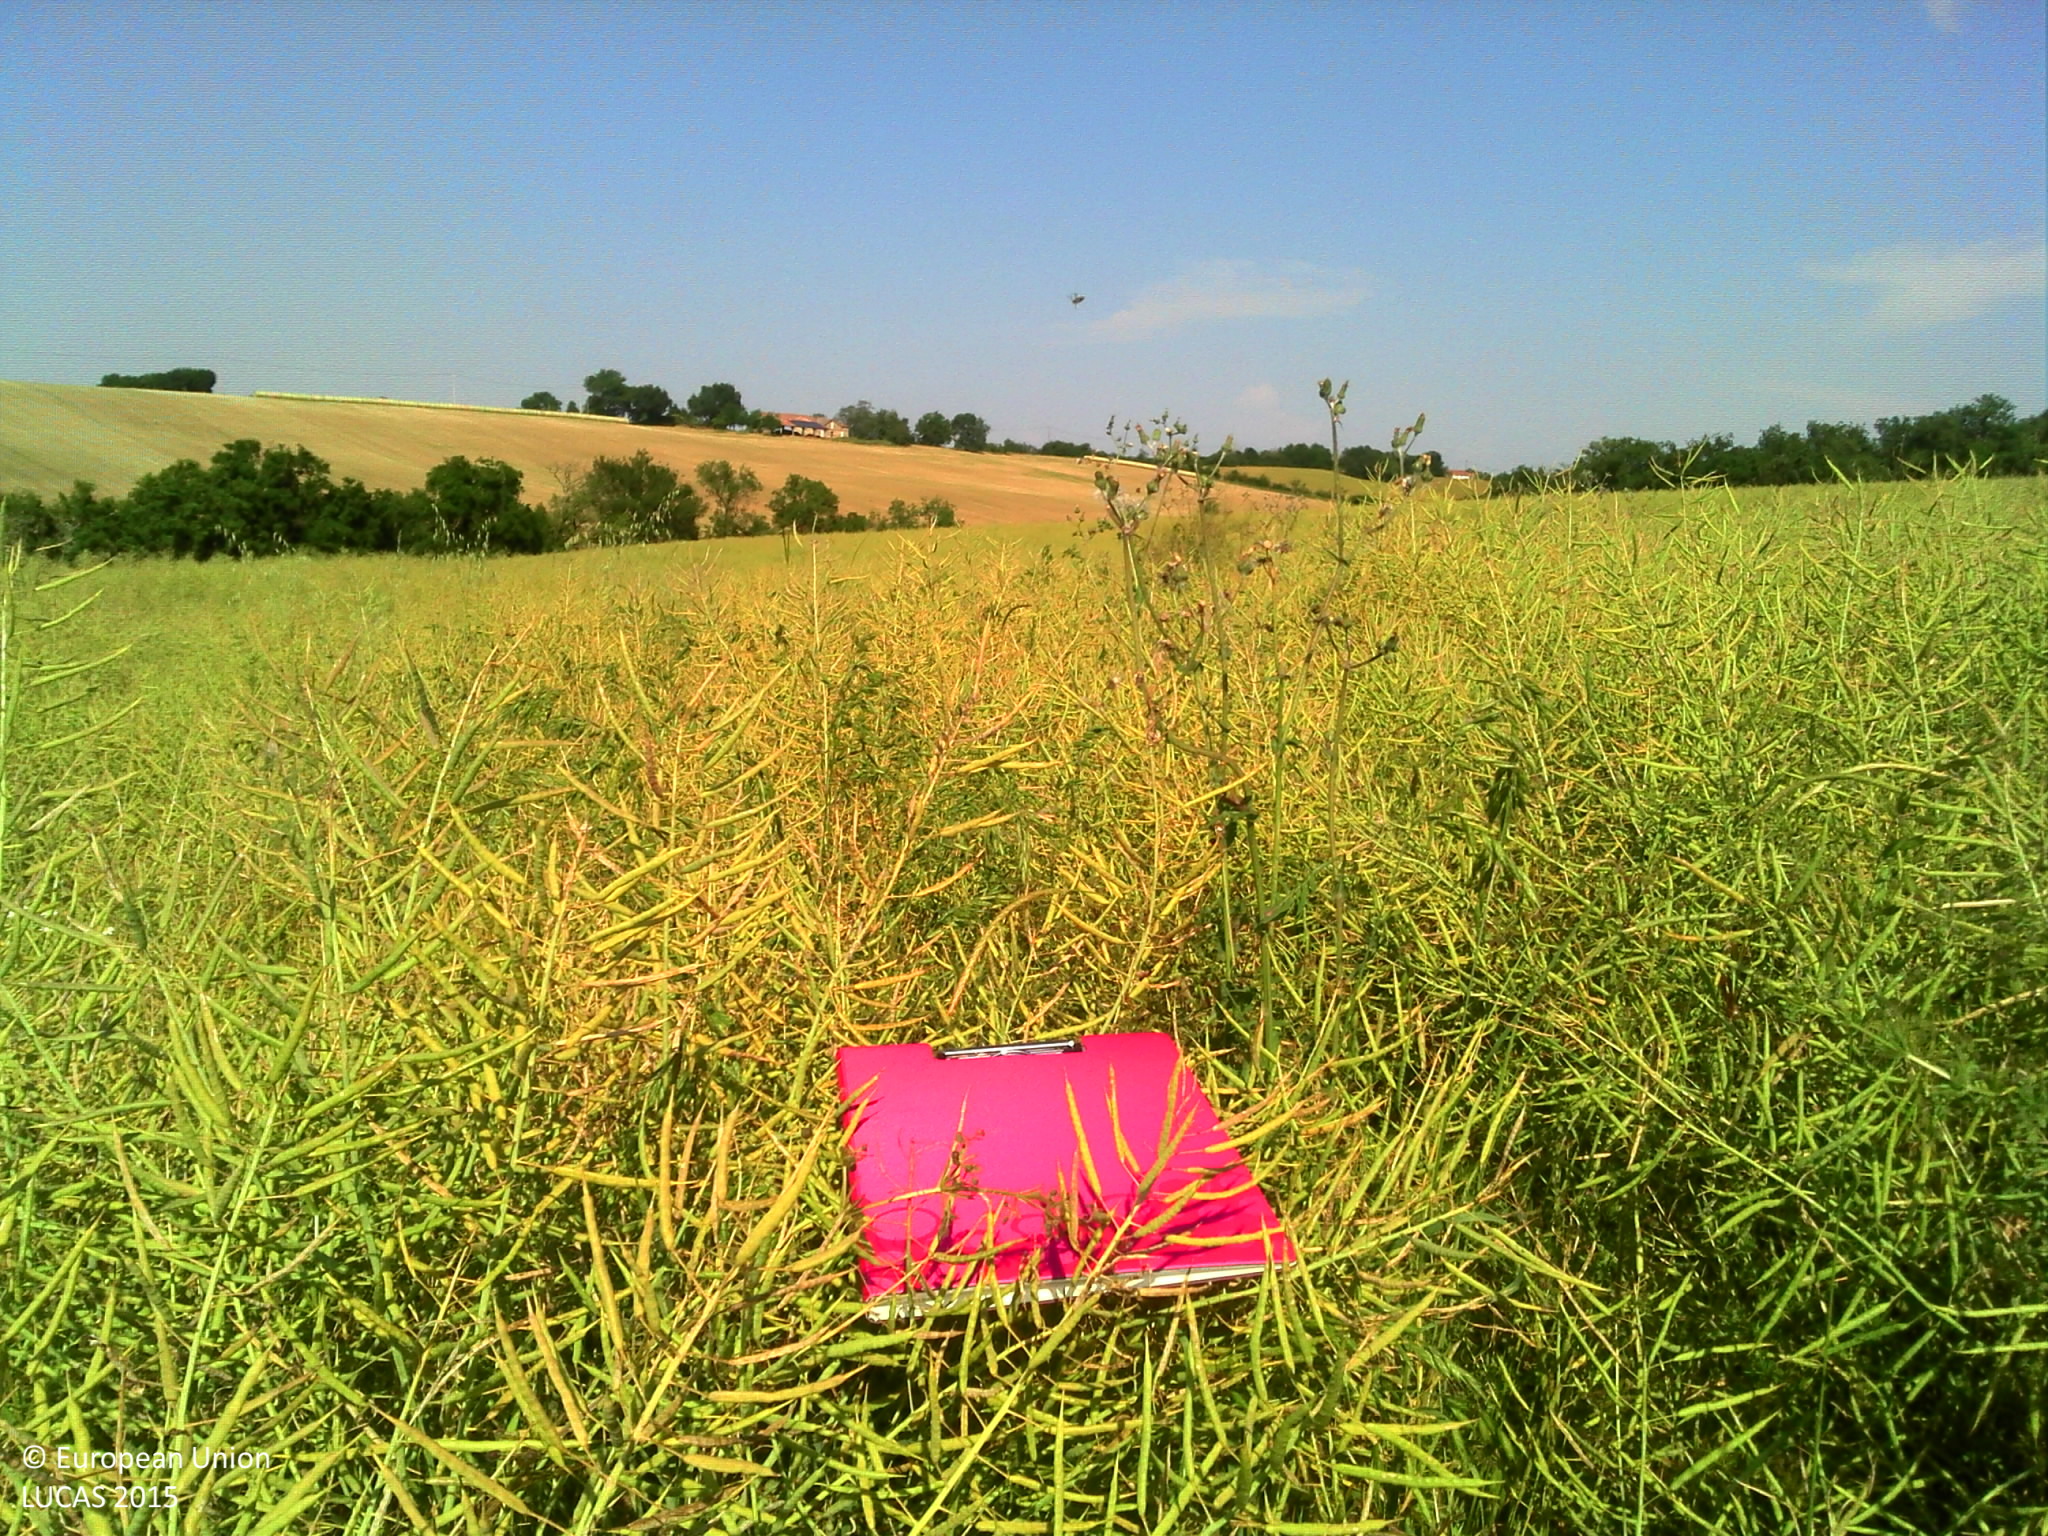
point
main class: Cropland
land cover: Rape and turnip rape
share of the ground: > 75 %
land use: Agriculture (excluding fallow land and kitchen gardens)
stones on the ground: < 10 %
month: June
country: FR
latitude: 43.6832
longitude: 0.7568
